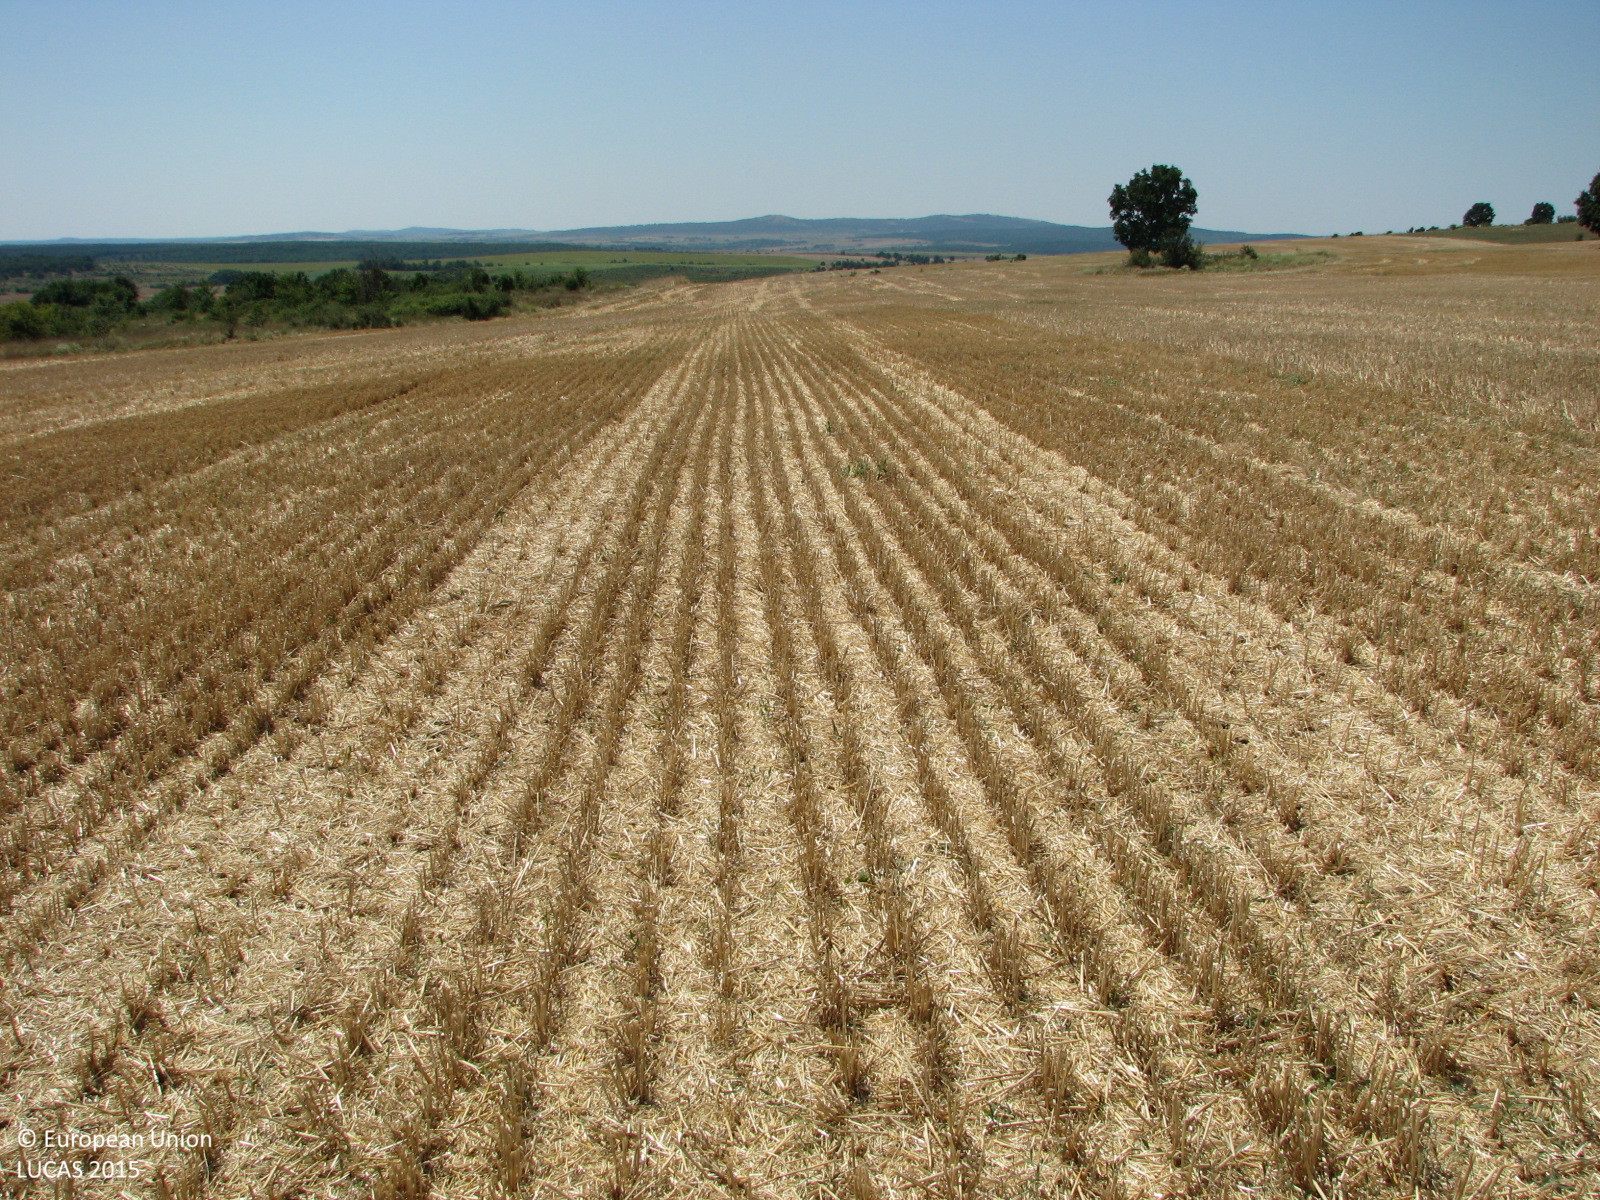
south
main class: Cropland
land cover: Common wheat
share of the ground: 25 - 50 %
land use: Agriculture (excluding fallow land and kitchen gardens)
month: July
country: BG
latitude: 42.1889
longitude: 26.8428
